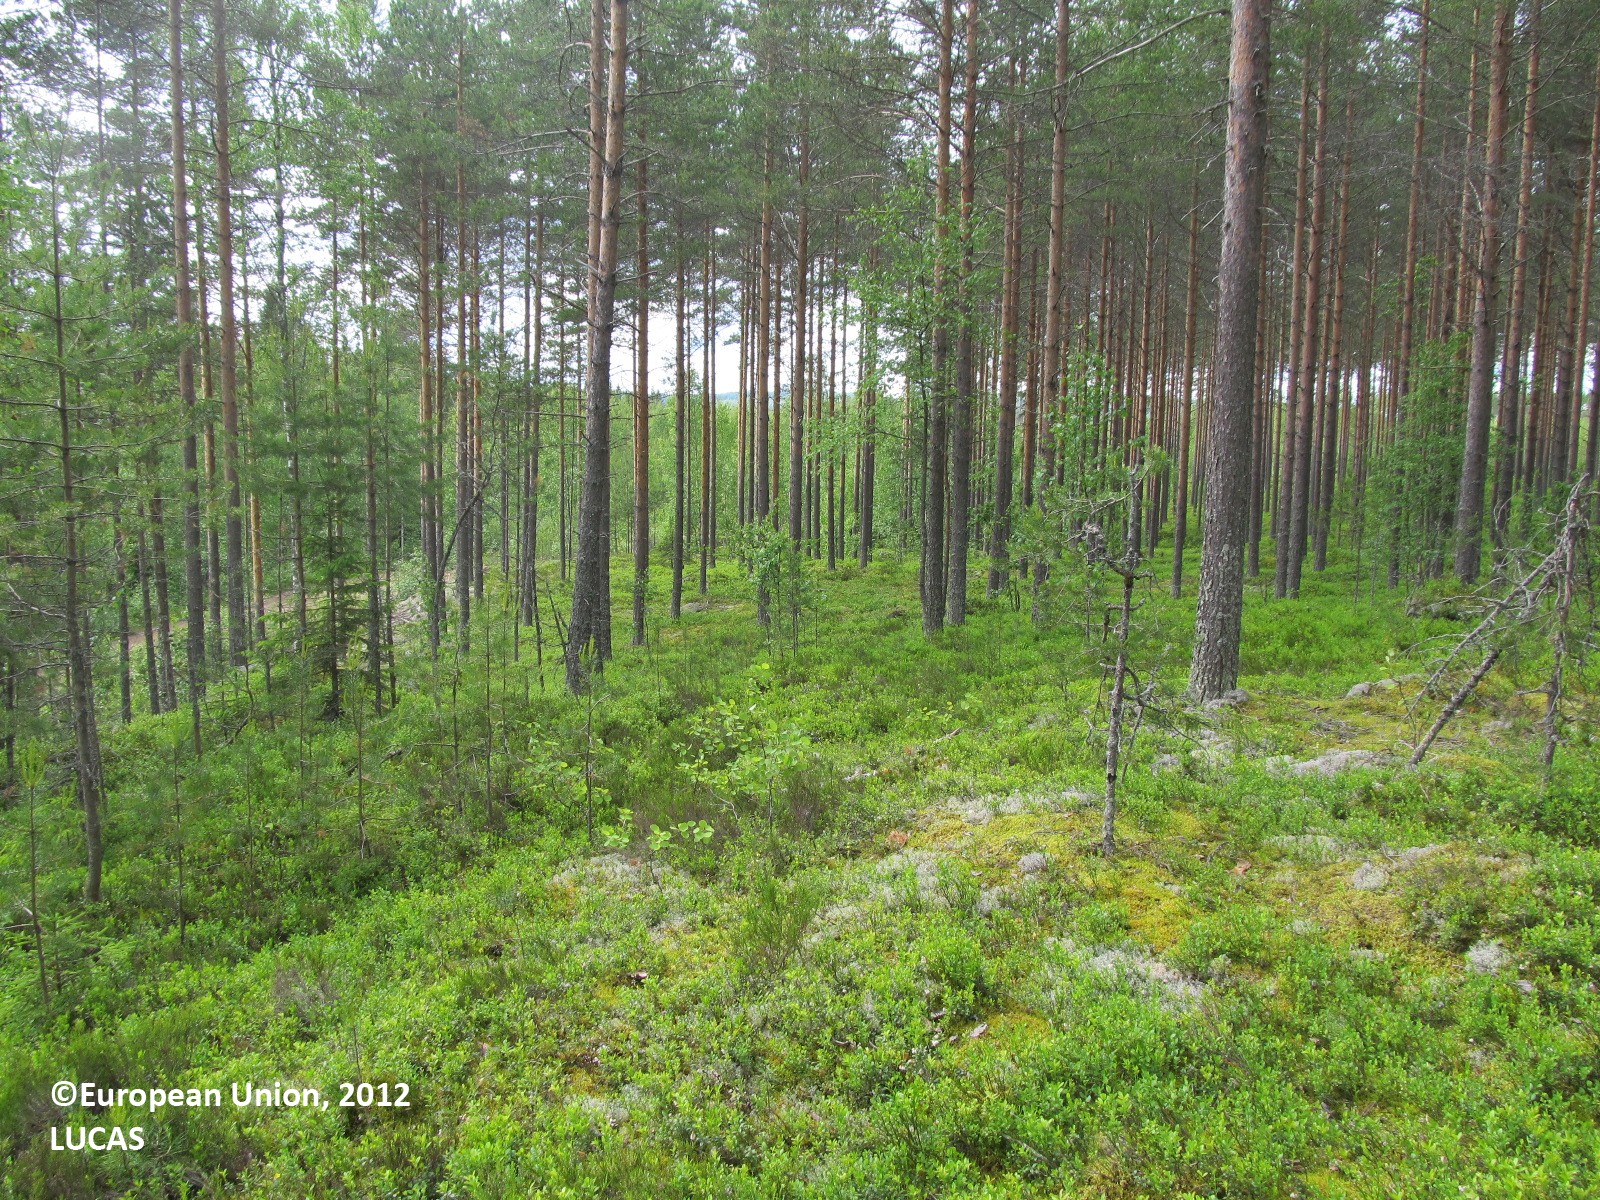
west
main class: Woodland
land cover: Pine dominated coniferous woodland
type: boreal forest
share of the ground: 50 - 75 %
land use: Forestry
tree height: > 5 m
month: June
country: FI
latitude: 62.9141
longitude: 28.8519
